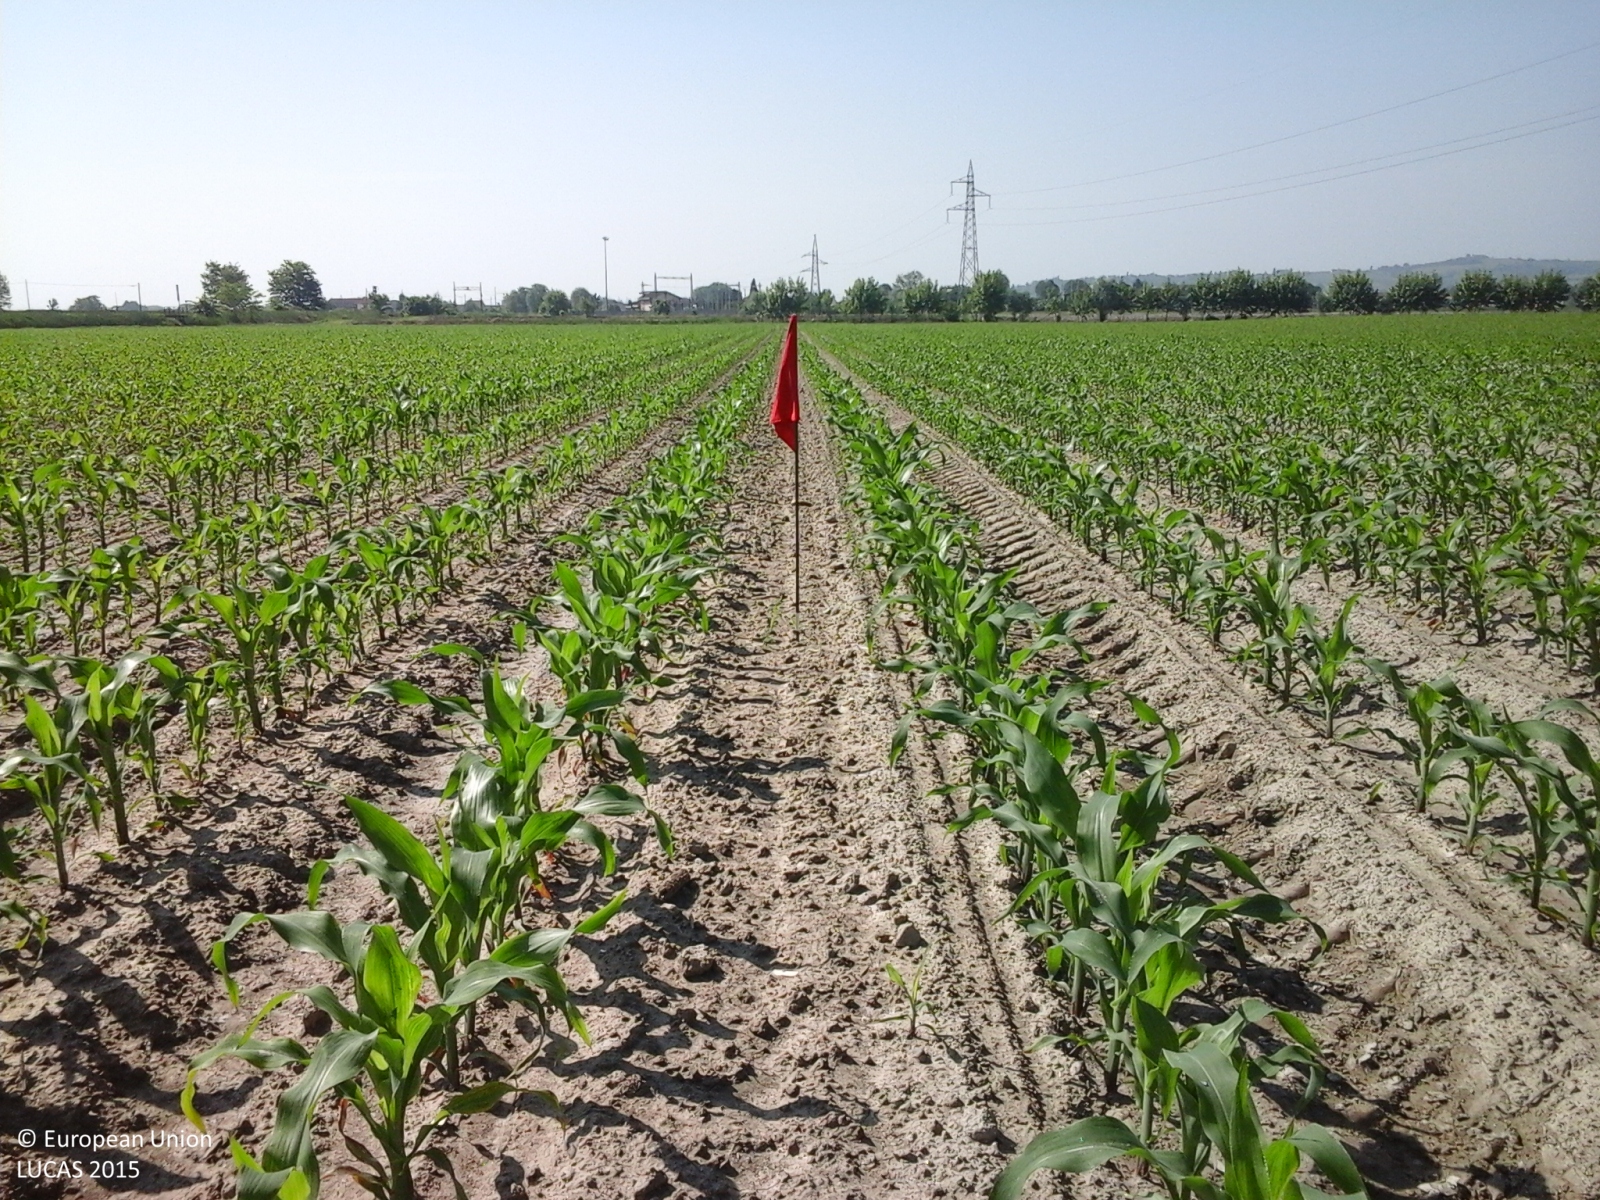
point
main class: Cropland
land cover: Maize
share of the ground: 25 - 50 %
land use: Agriculture (excluding fallow land and kitchen gardens)
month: May
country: IT
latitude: 45.1684
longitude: 8.4379
